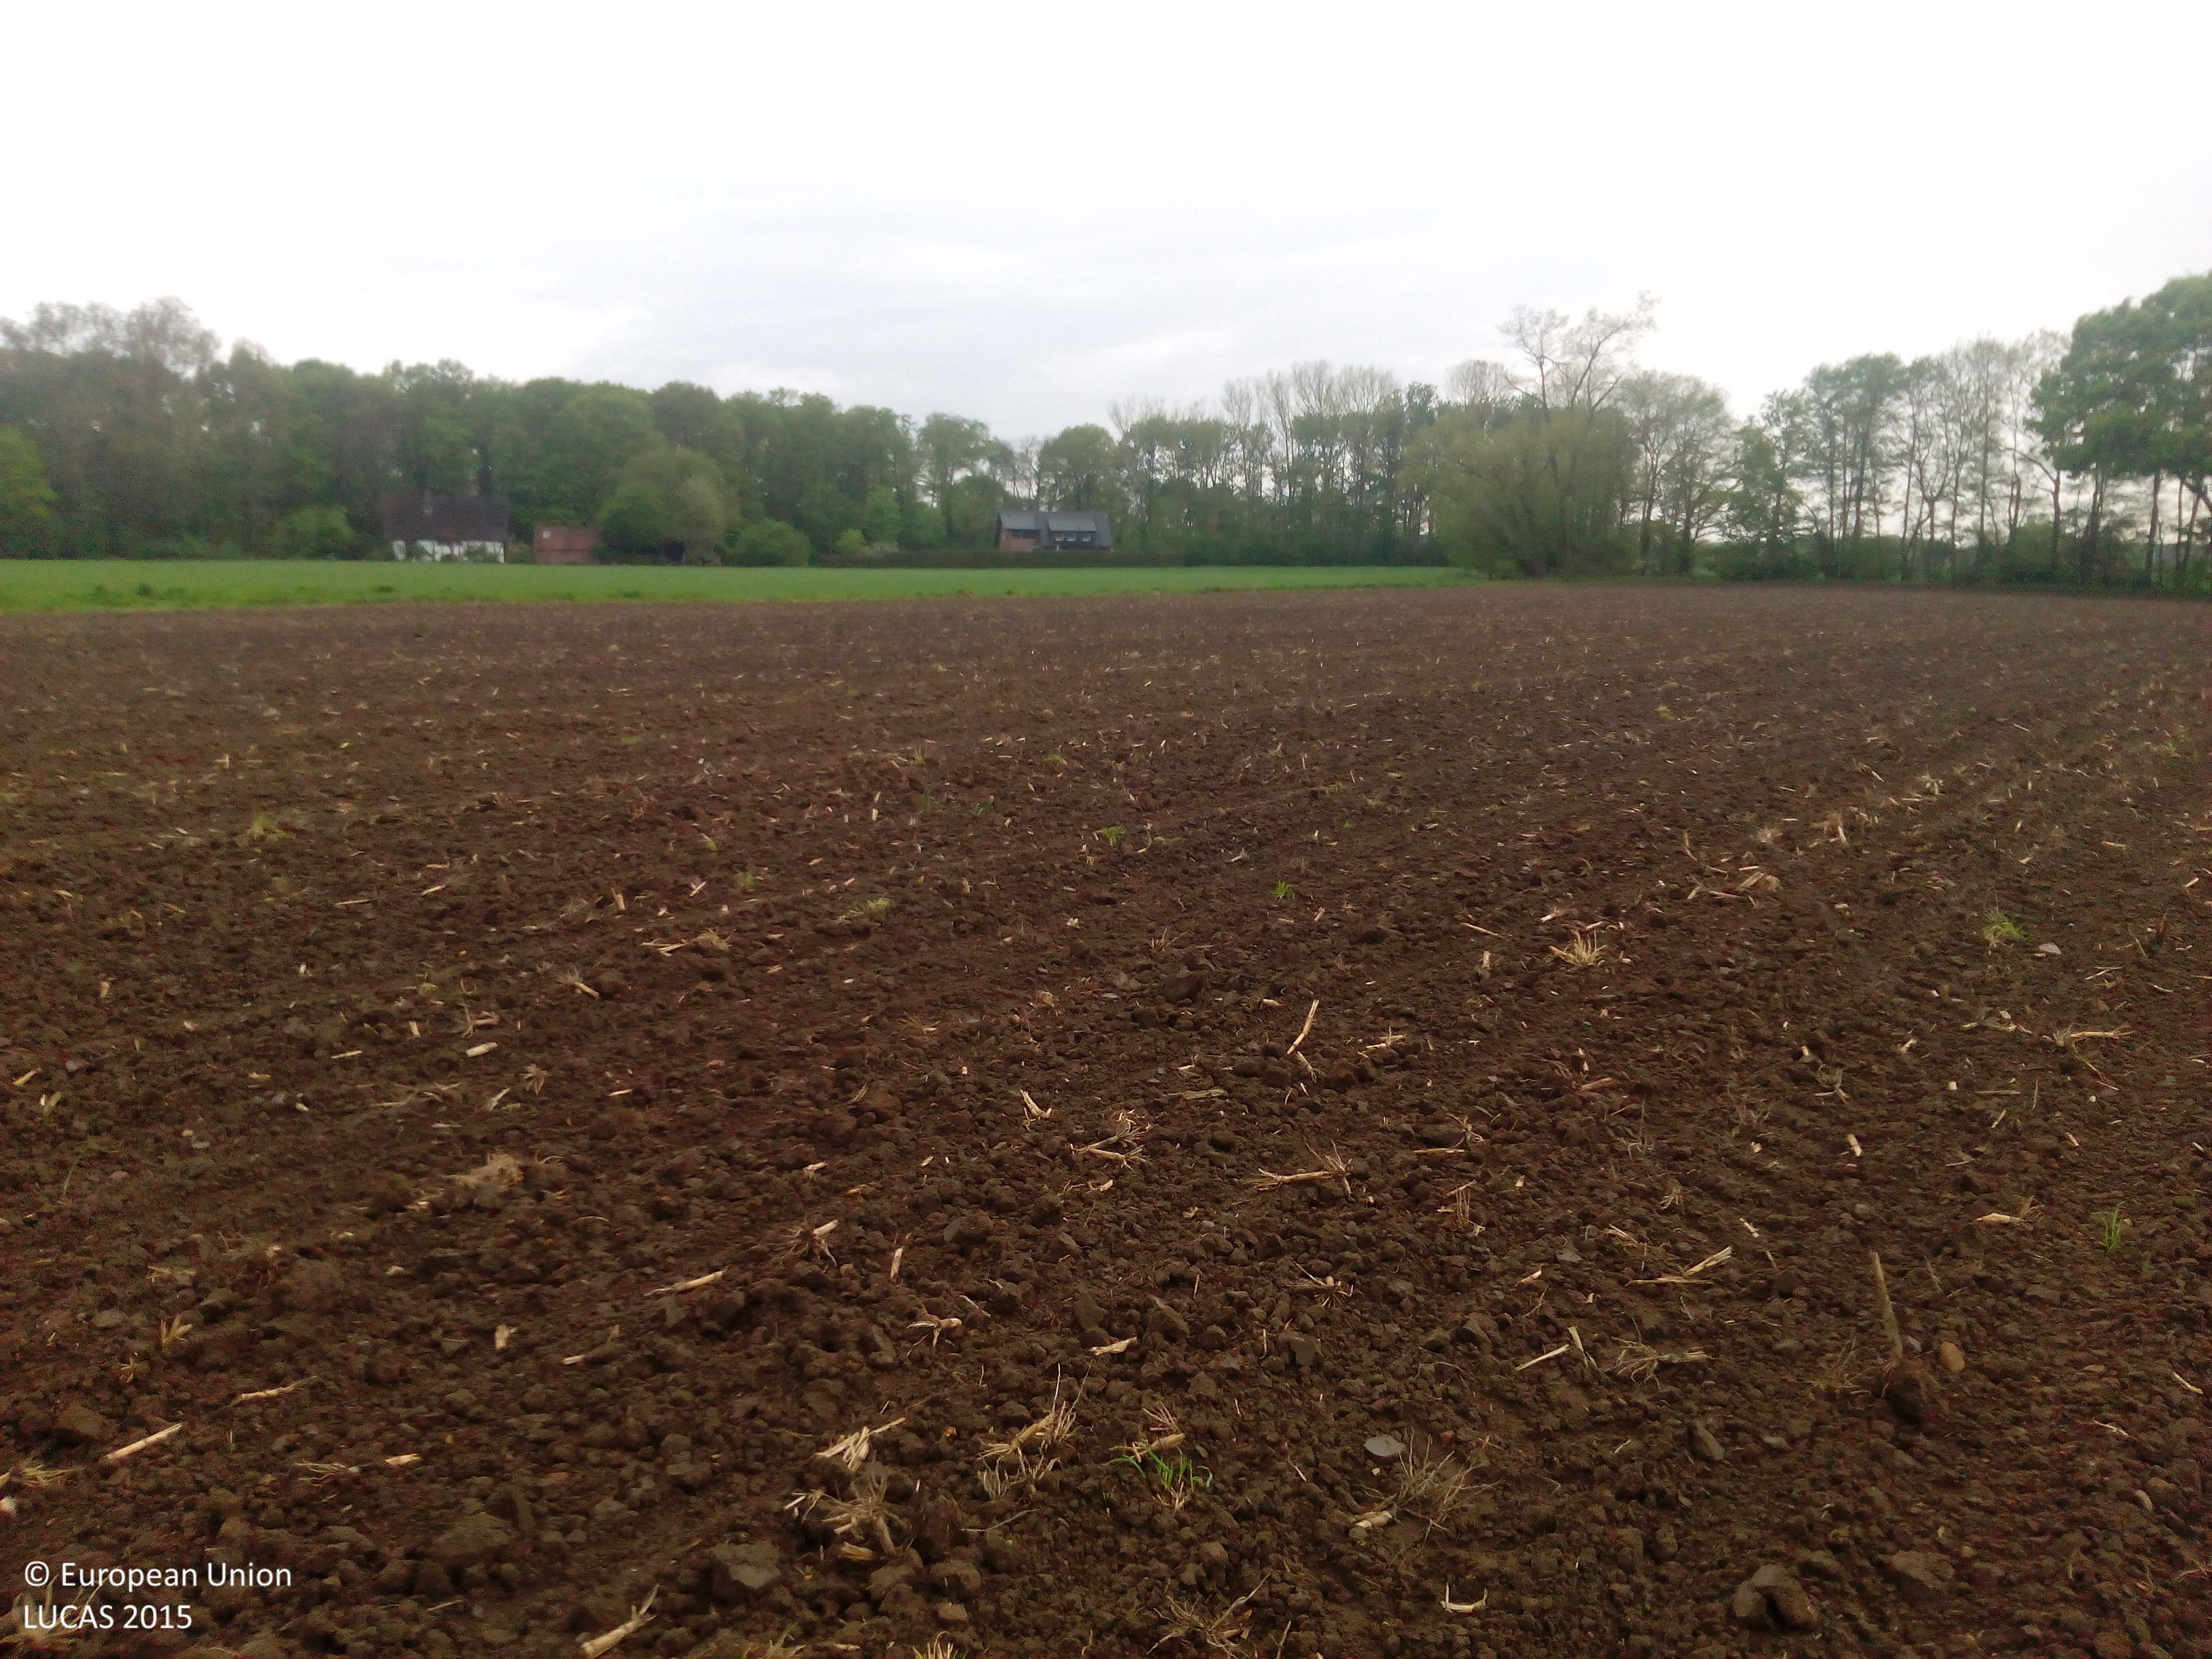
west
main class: Cropland
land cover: Maize
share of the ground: < 10 %
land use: Agriculture (excluding fallow land and kitchen gardens)
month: May
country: DE
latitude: 51.8648
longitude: 7.4589
